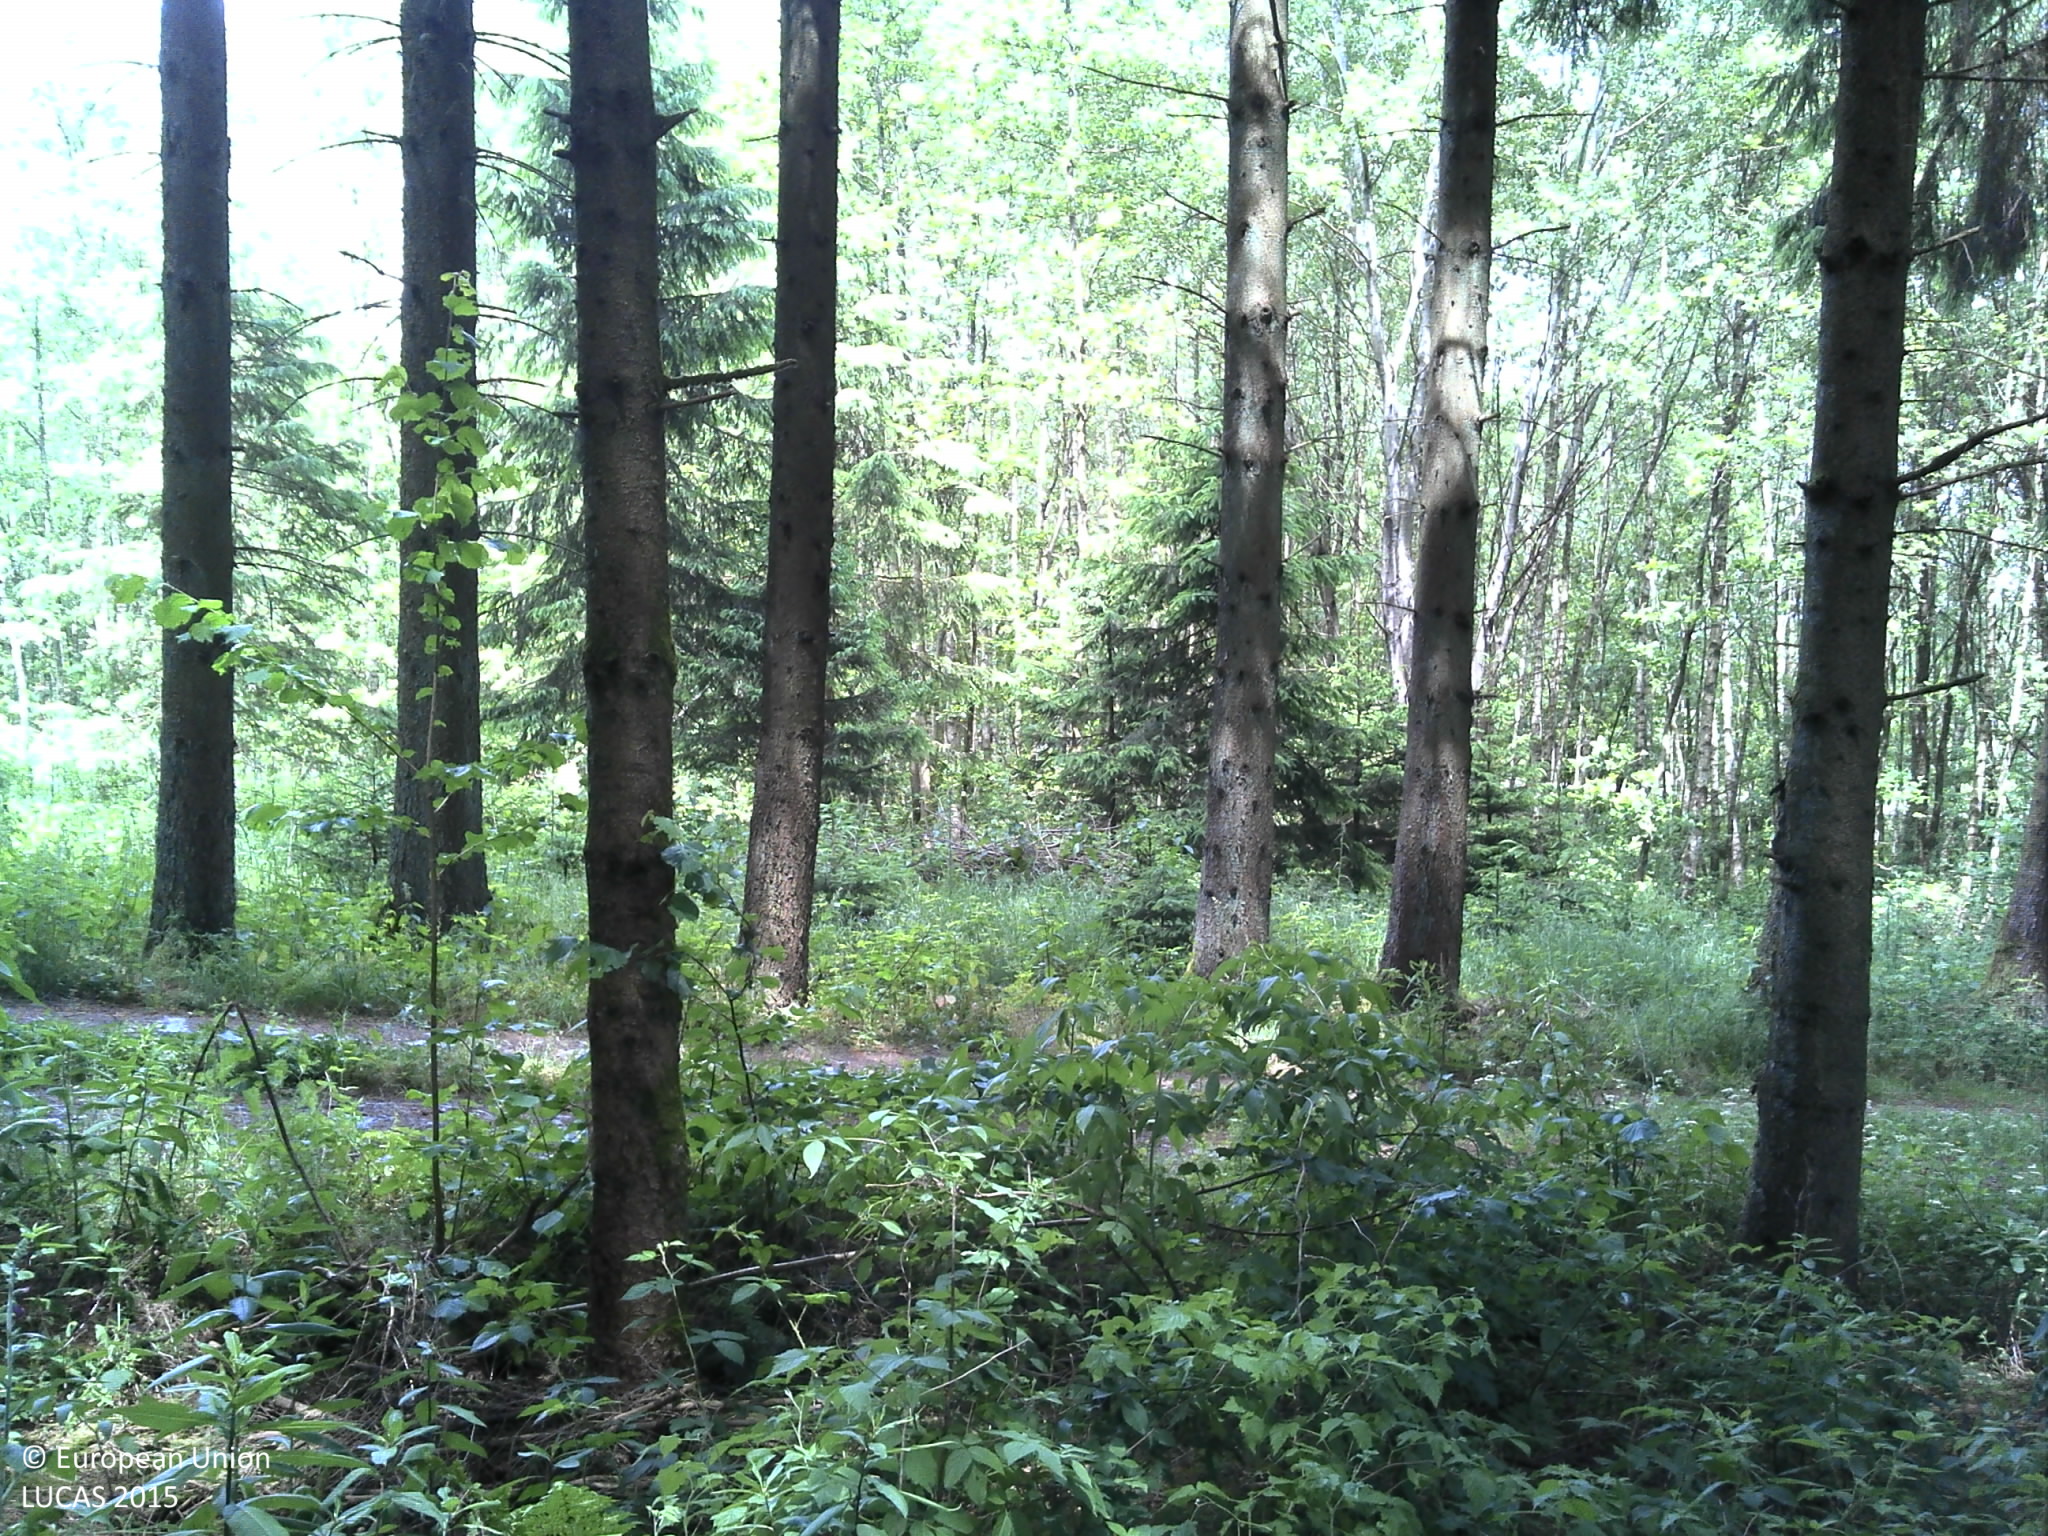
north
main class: Woodland
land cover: Spruce dominated coniferous woodland
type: exotic forest
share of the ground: > 75 %
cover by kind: coniferous forest trees 75 %, herbaceous plants 10 %, lichens and mosses 10 %, consolidated bare surface 5 %
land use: Forestry
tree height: > 5 m
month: June
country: LU
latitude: 50.0039
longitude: 5.9389
